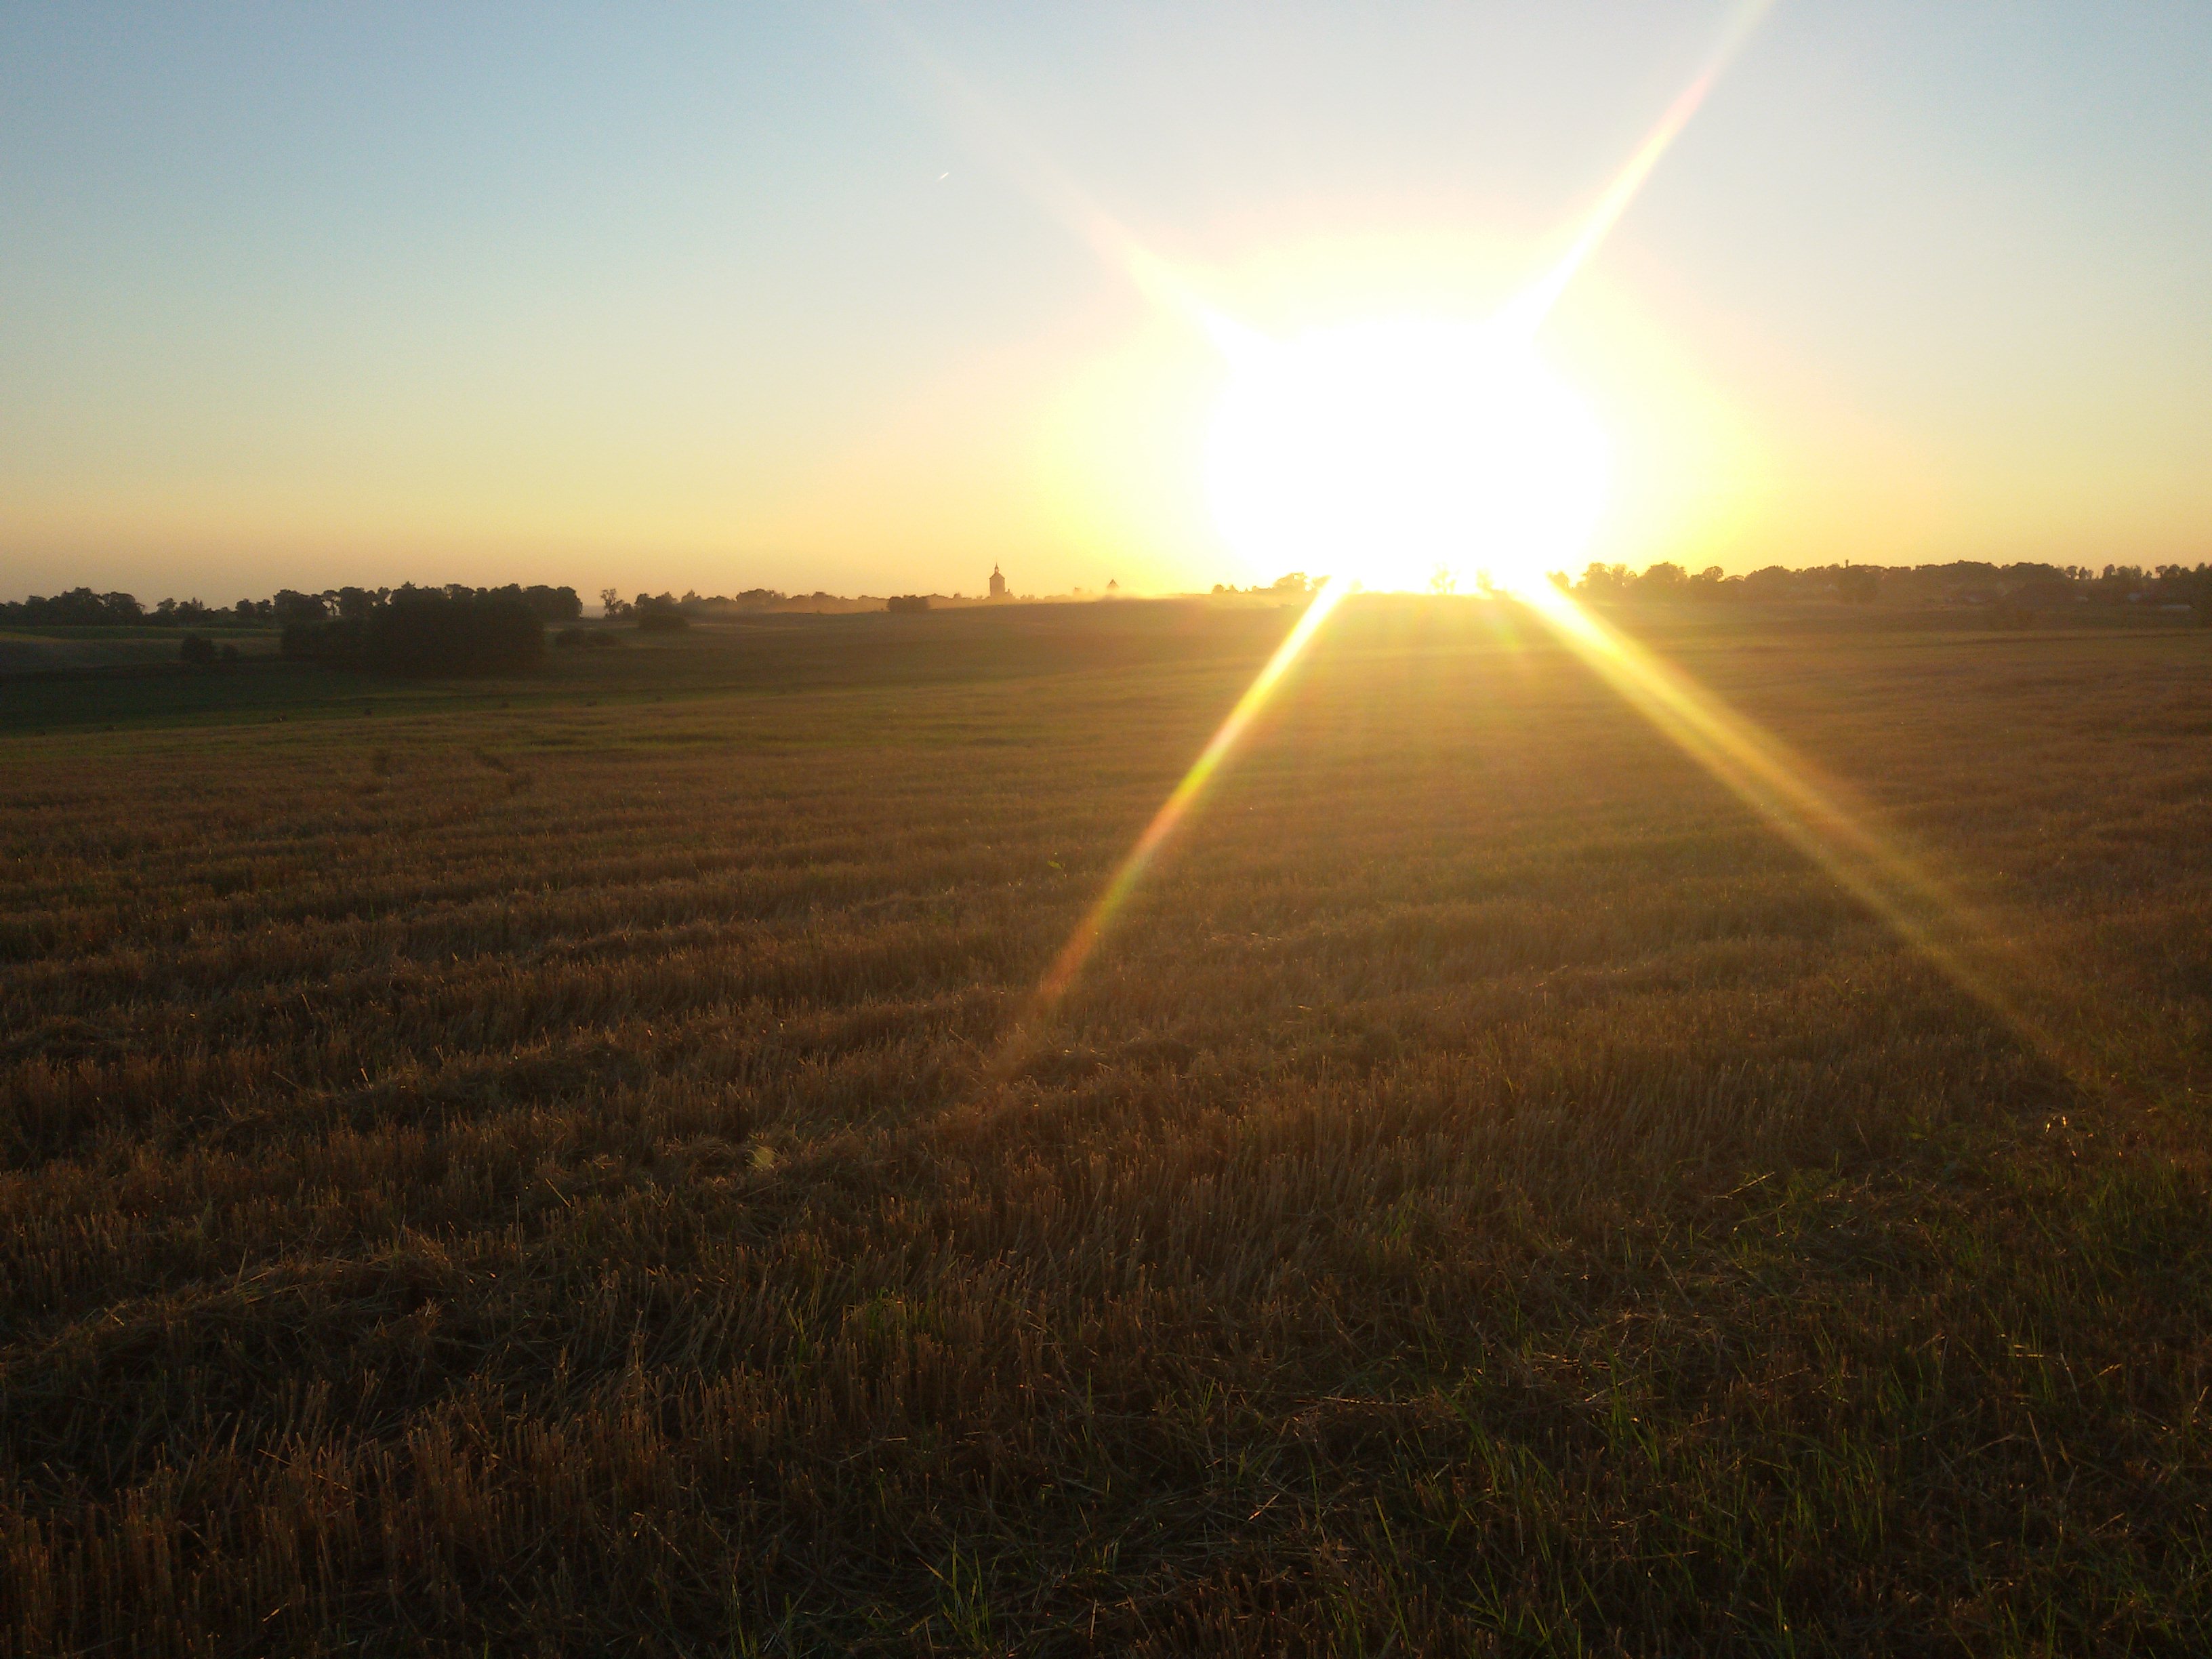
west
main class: Cropland
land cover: Common wheat
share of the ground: > 75 %
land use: Agriculture (excluding fallow land and kitchen gardens)
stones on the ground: < 10 %
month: August
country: PL
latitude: 54.0447
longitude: 21.1782
